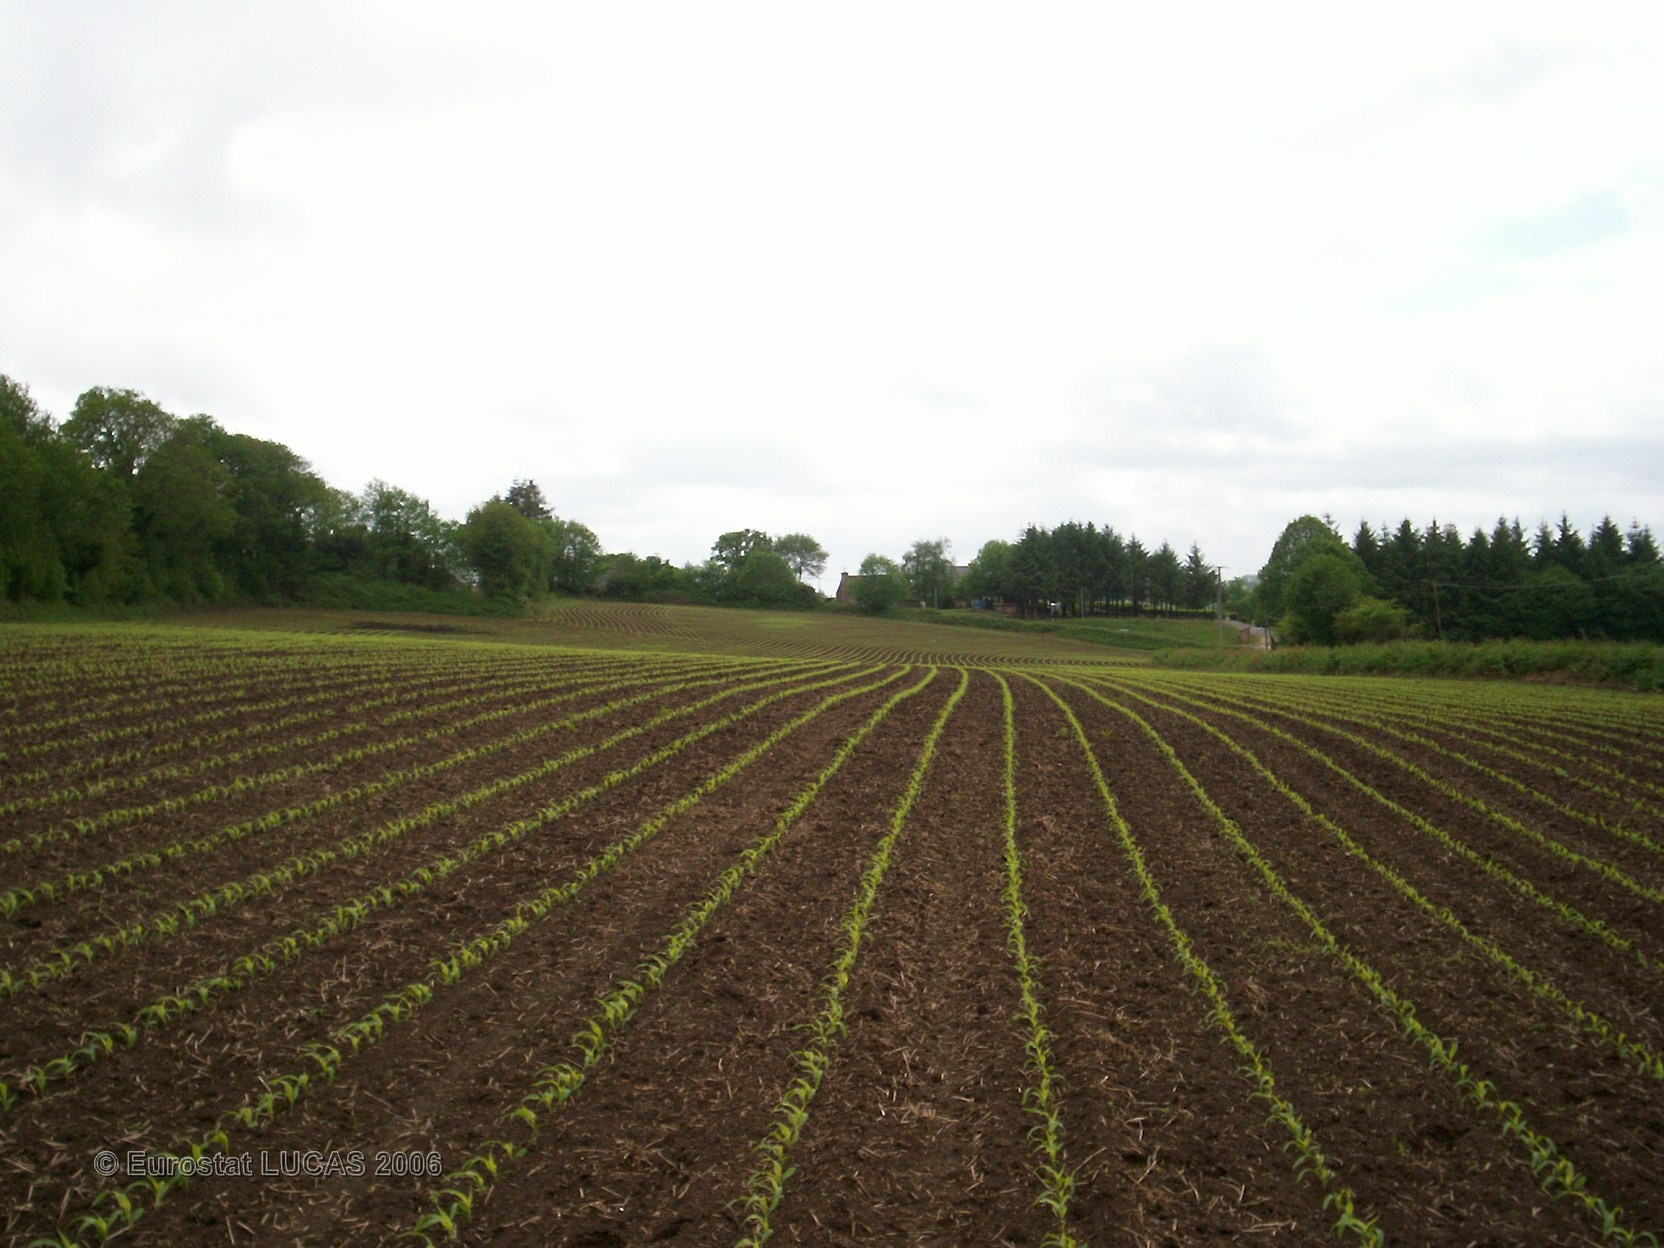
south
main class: Cropland
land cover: Maize
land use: Agriculture (excluding fallow land and kitchen gardens)
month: May
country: FR
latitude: 47.9752
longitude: -3.6223
